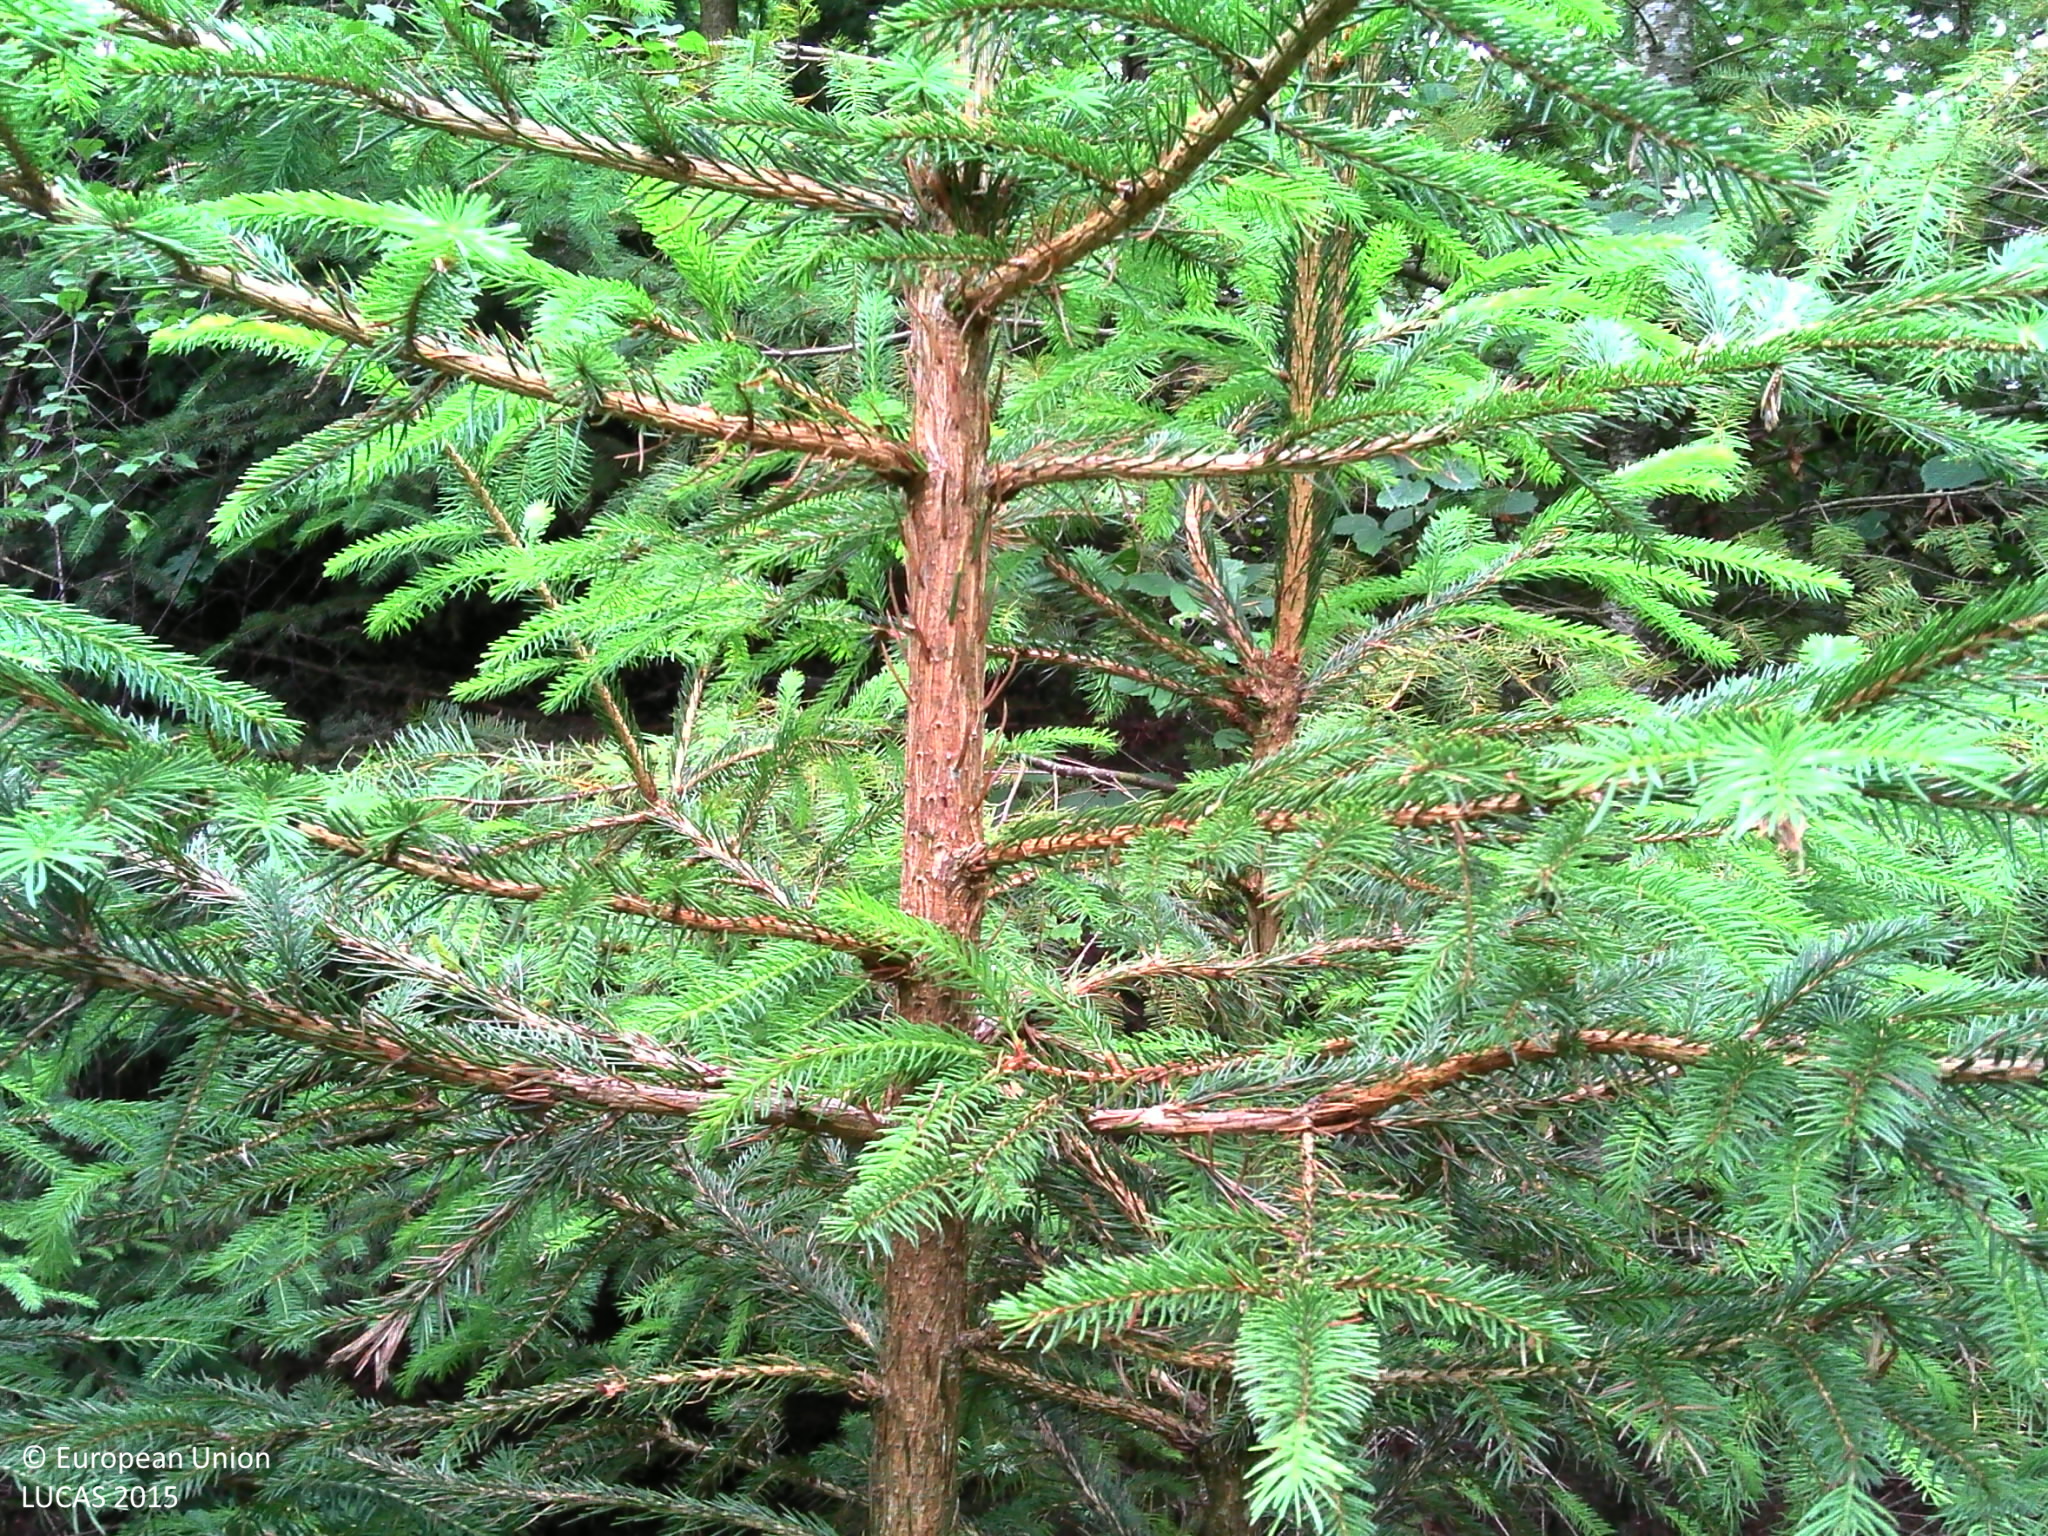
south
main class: Woodland
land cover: Spruce dominated coniferous woodland
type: alpine coniferous forest
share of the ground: > 75 %
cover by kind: coniferous forest trees 100 %
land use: Forestry
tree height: > 5 m
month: June
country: BE
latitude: 49.8739
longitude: 5.3645
